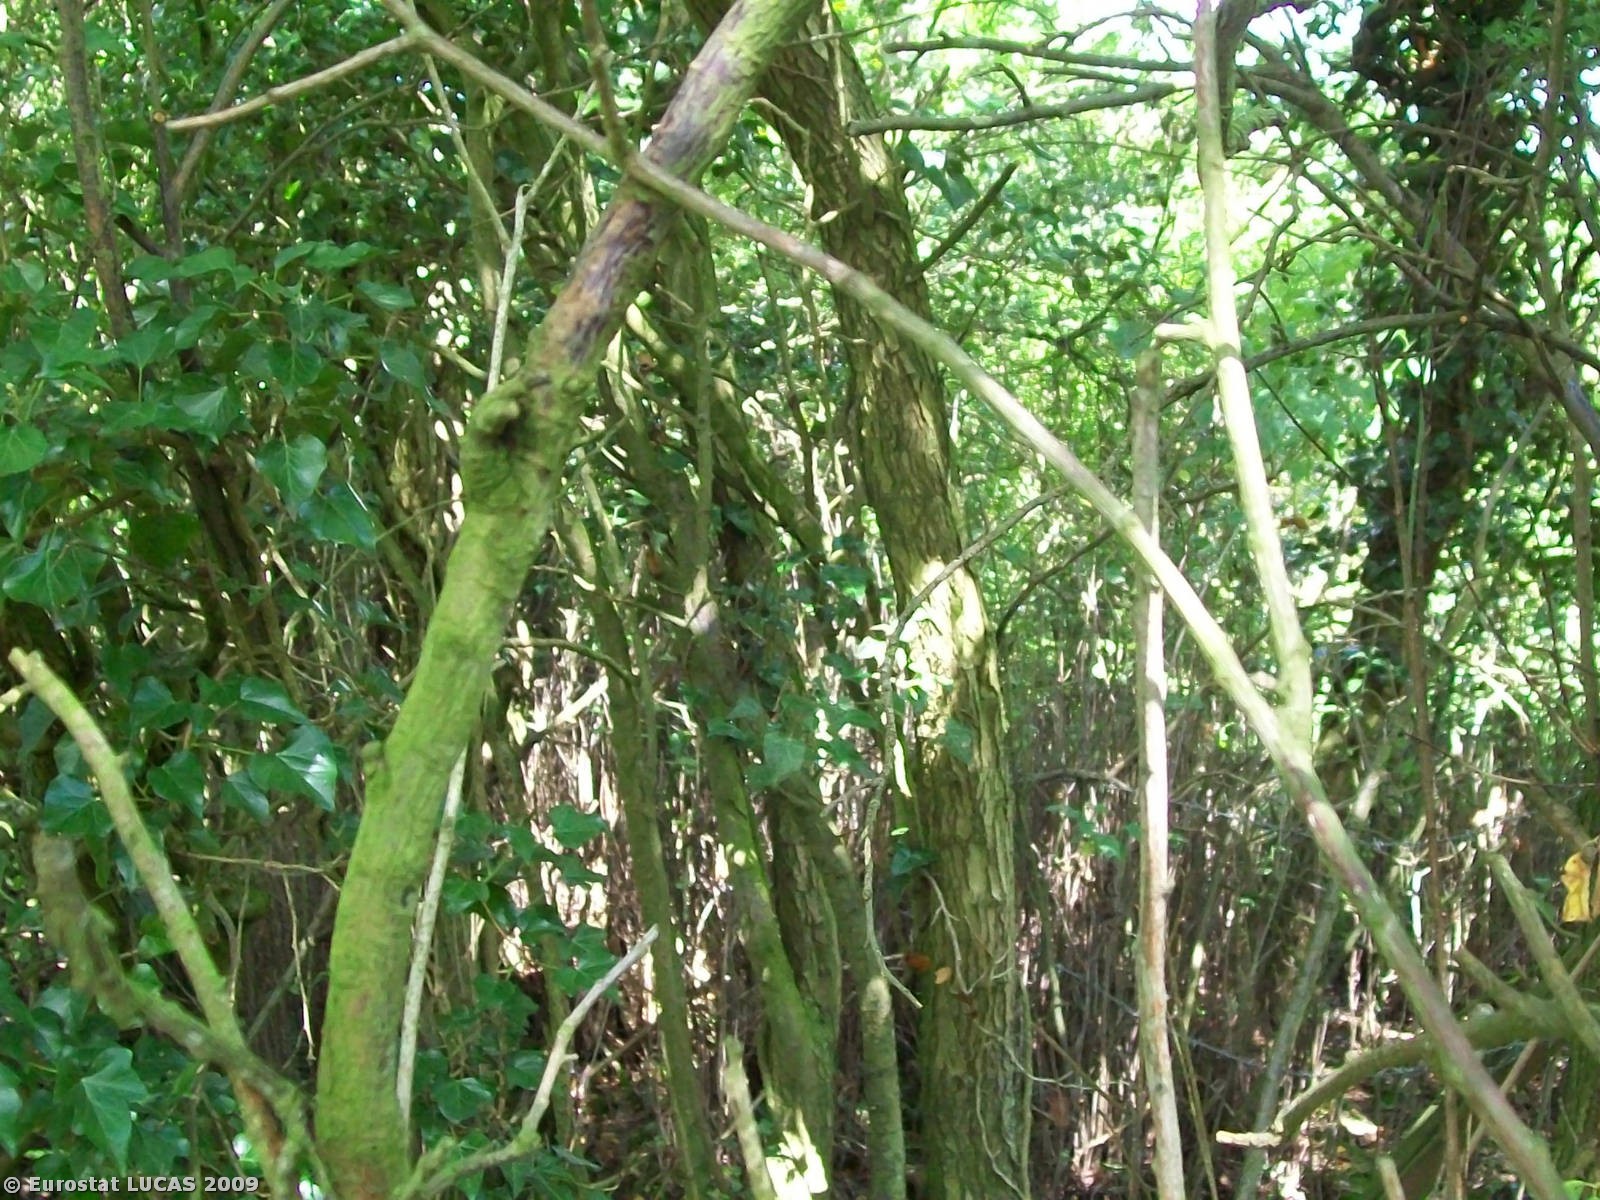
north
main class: Woodland
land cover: Broadleaved woodland
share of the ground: > 75 %
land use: Unused
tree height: > 5 m
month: August
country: GB
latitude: 51.6021
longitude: -2.3506
